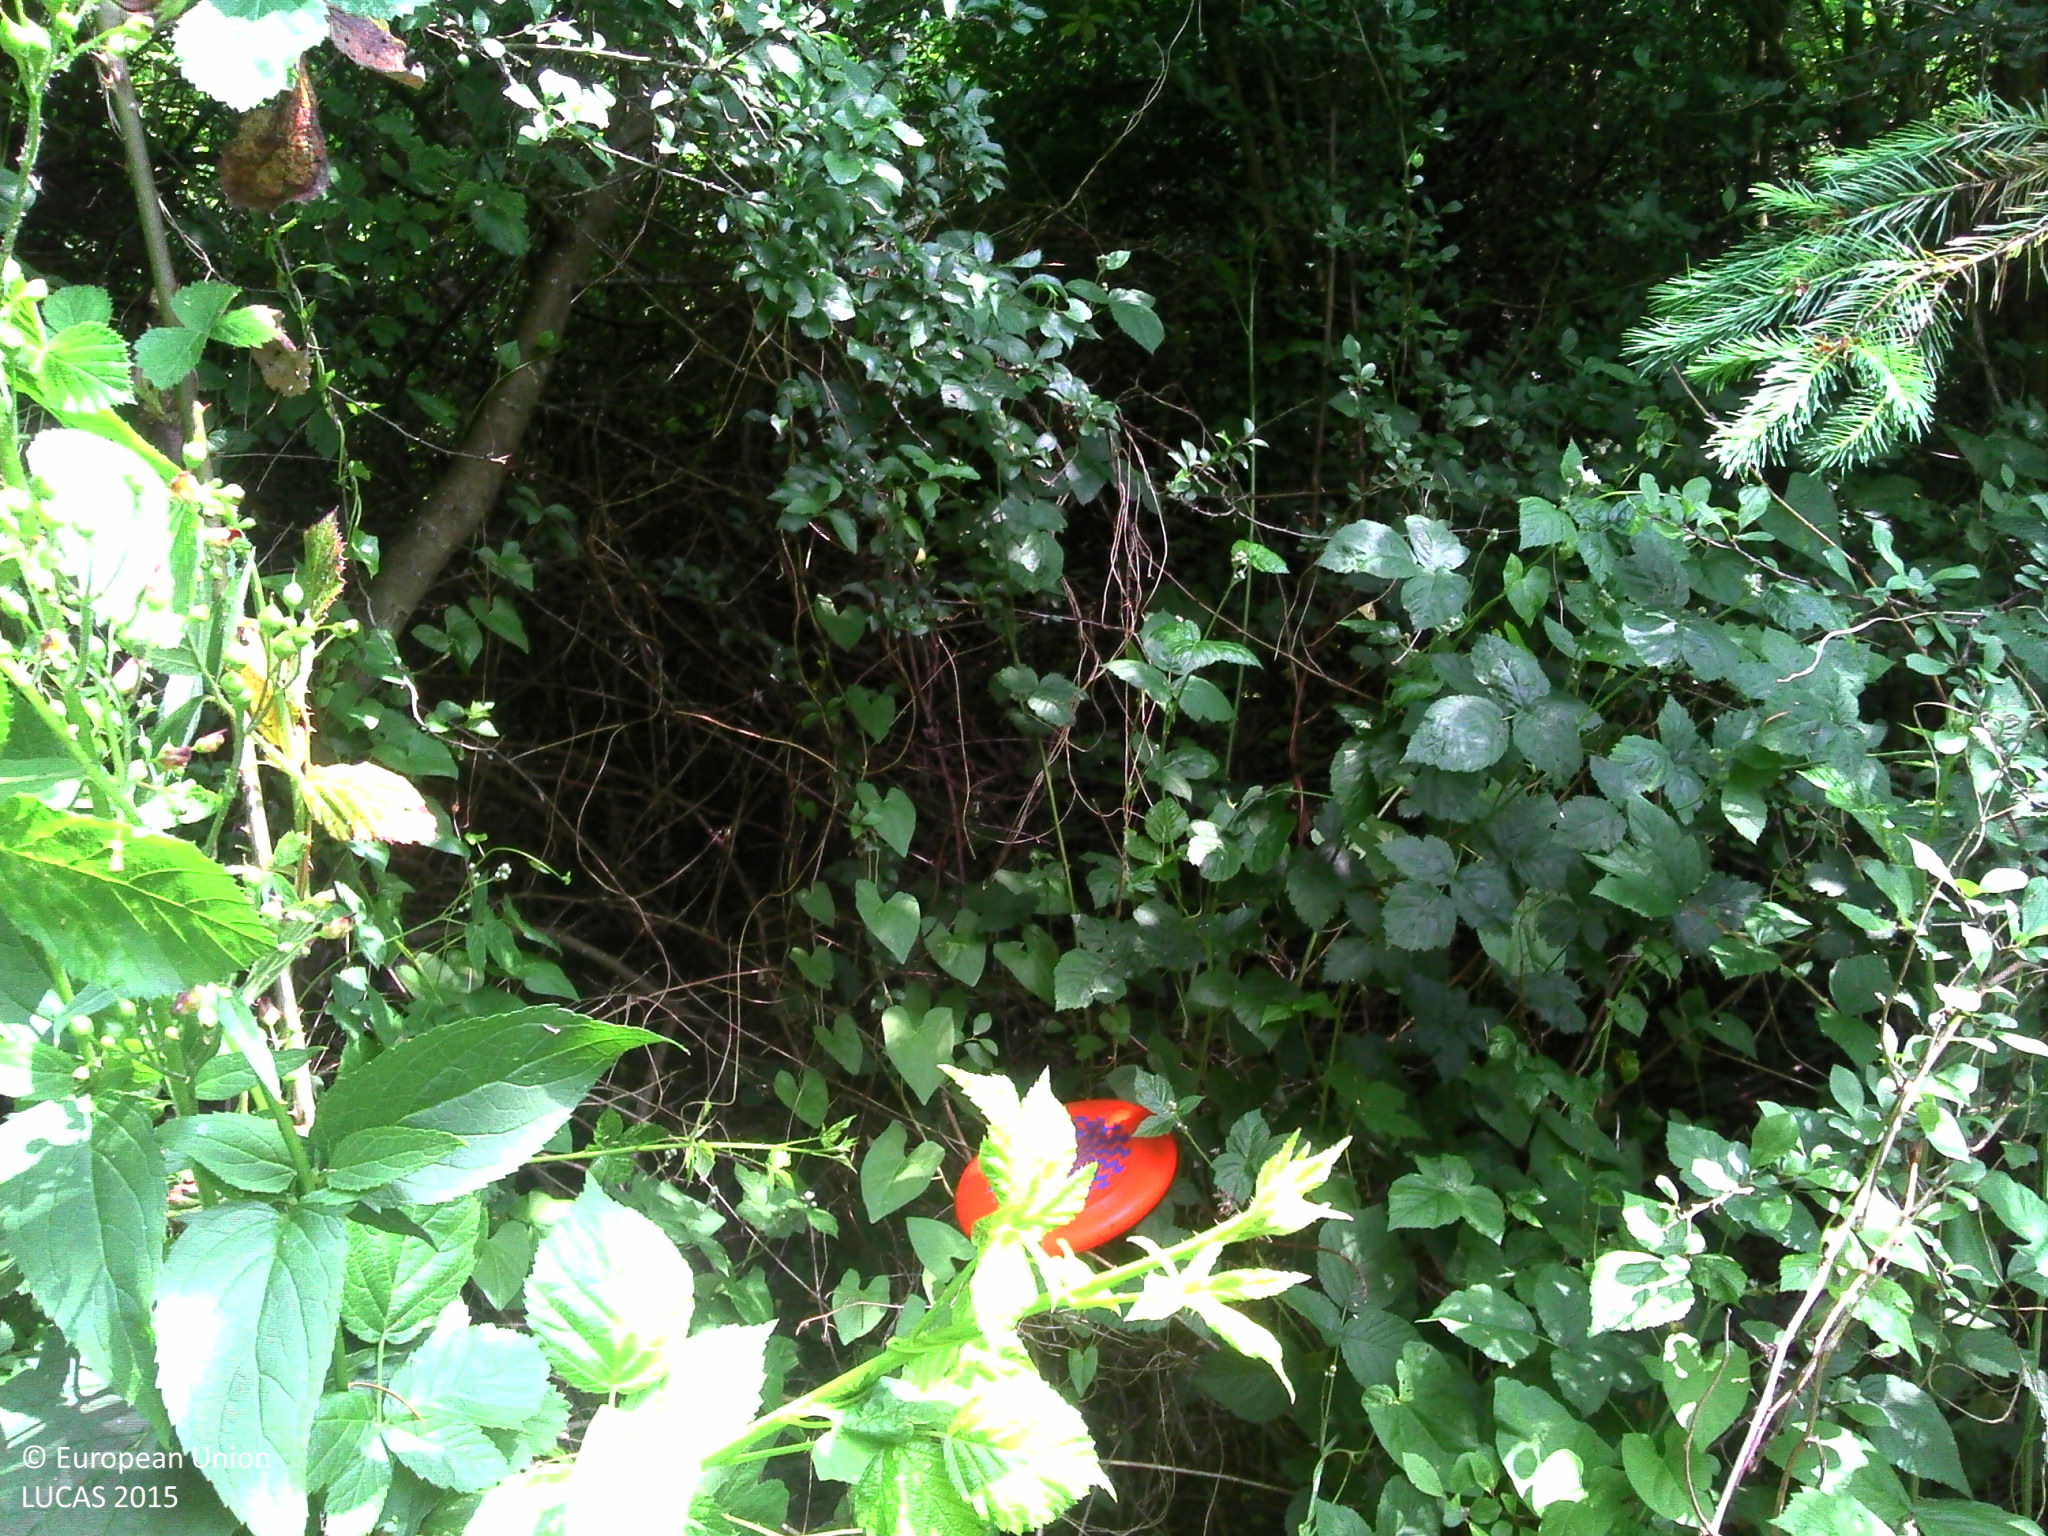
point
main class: Woodland
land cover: Broadleaved woodland
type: mesophytic deciduous forest
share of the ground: 50 - 75 %
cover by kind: broadleaved forest trees 65 %, shrubs 20 %, herbaceous plants 10 %, coniferous forest trees 5 %
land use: Forestry
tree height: > 5 m
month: June
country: BE
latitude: 50.3482
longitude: 5.5153
